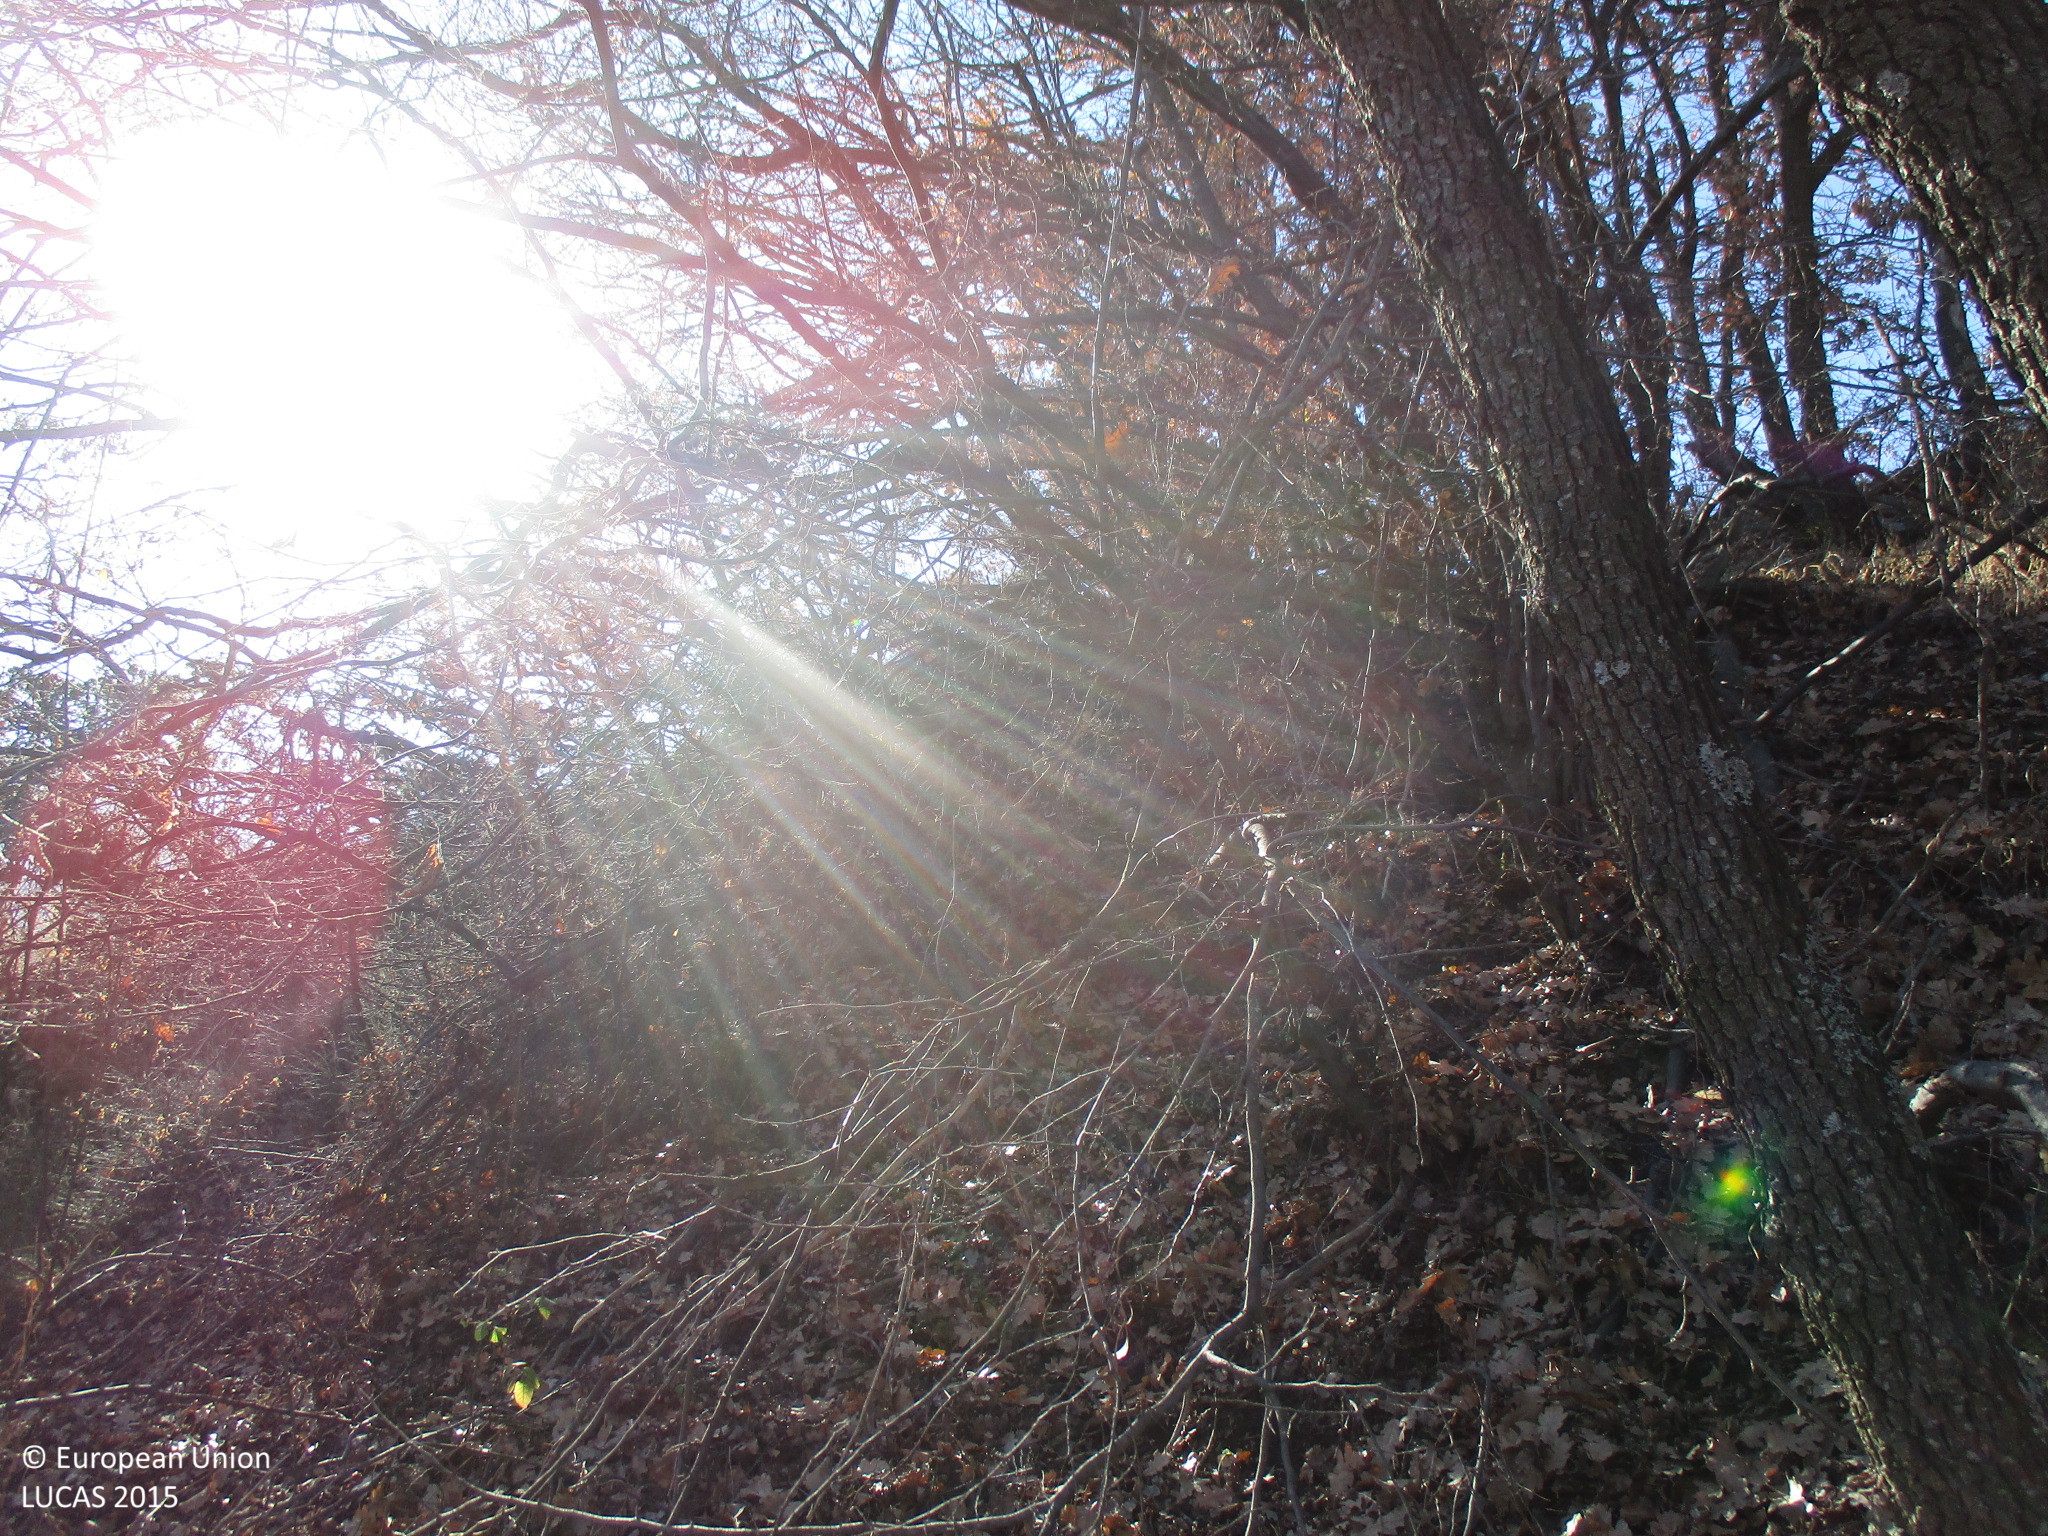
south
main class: Woodland
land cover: Broadleaved woodland
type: mesophytic deciduous forest
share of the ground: > 75 %
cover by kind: broadleaved forest trees 95 %, unconsolidated bare surface 5 %
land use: Forestry
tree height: > 5 m
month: December
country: BG
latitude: 42.0433
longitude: 24.6299
